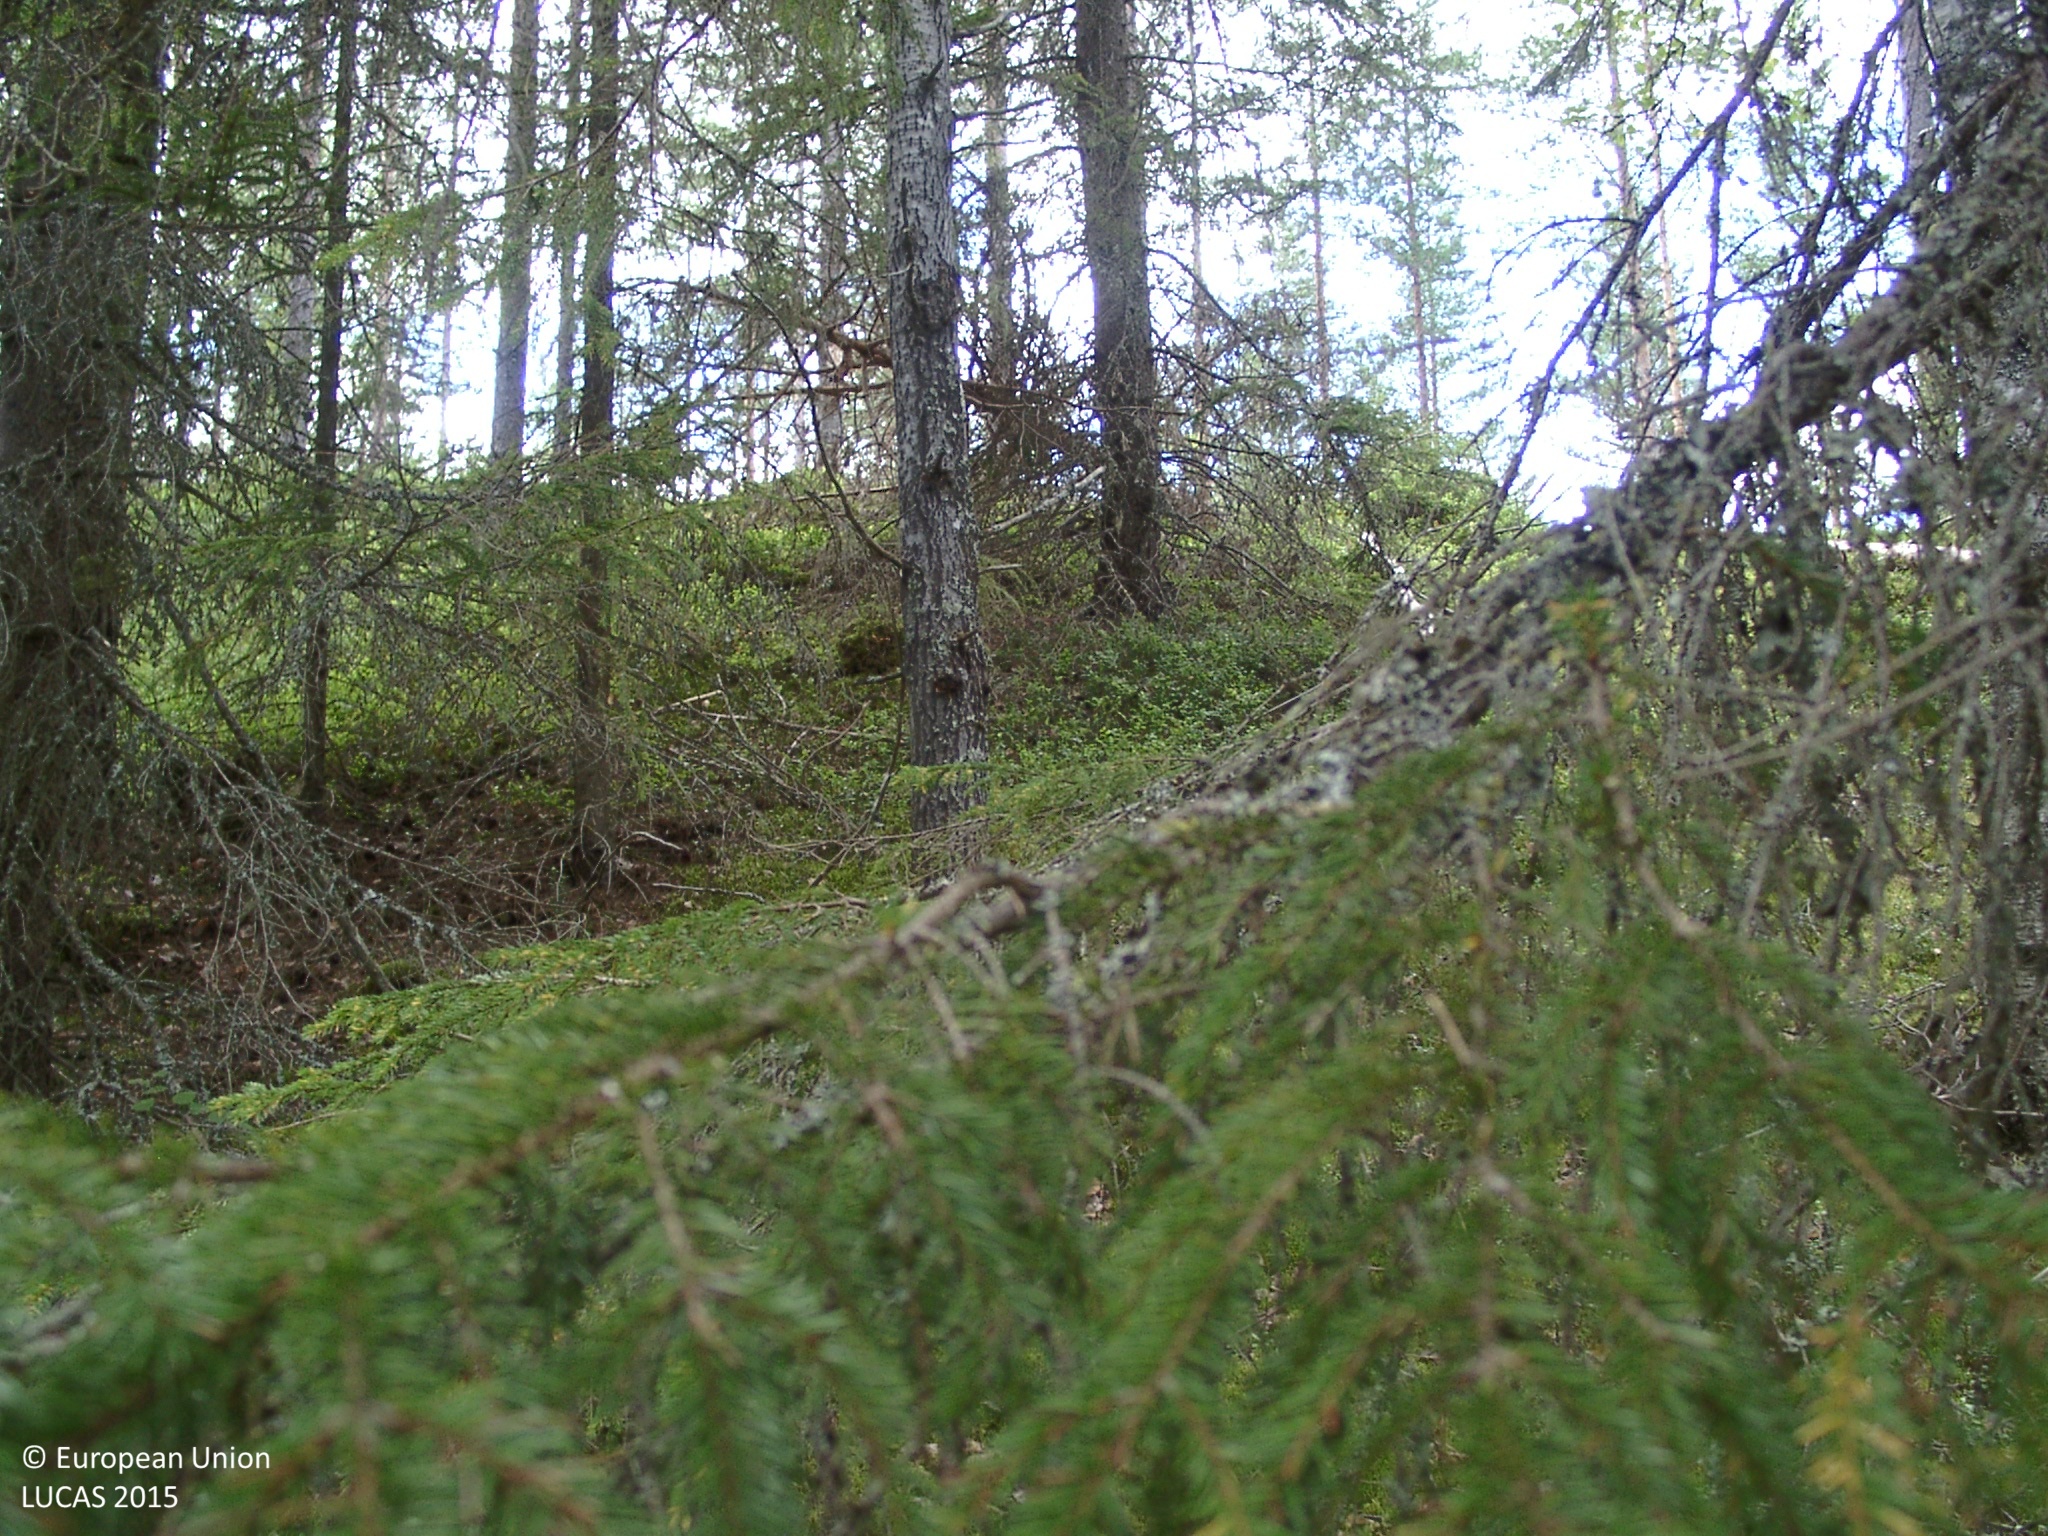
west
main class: Woodland
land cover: Other mixed woodland
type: boreal forest
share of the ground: 50 - 75 %
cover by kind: coniferous forest trees 50 %, broadleaved forest trees 20 %, shrubs 20 %, lichens and mosses 10 %
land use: Forestry
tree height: > 5 m
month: August
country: FI
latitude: 62.3935
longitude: 25.4908
